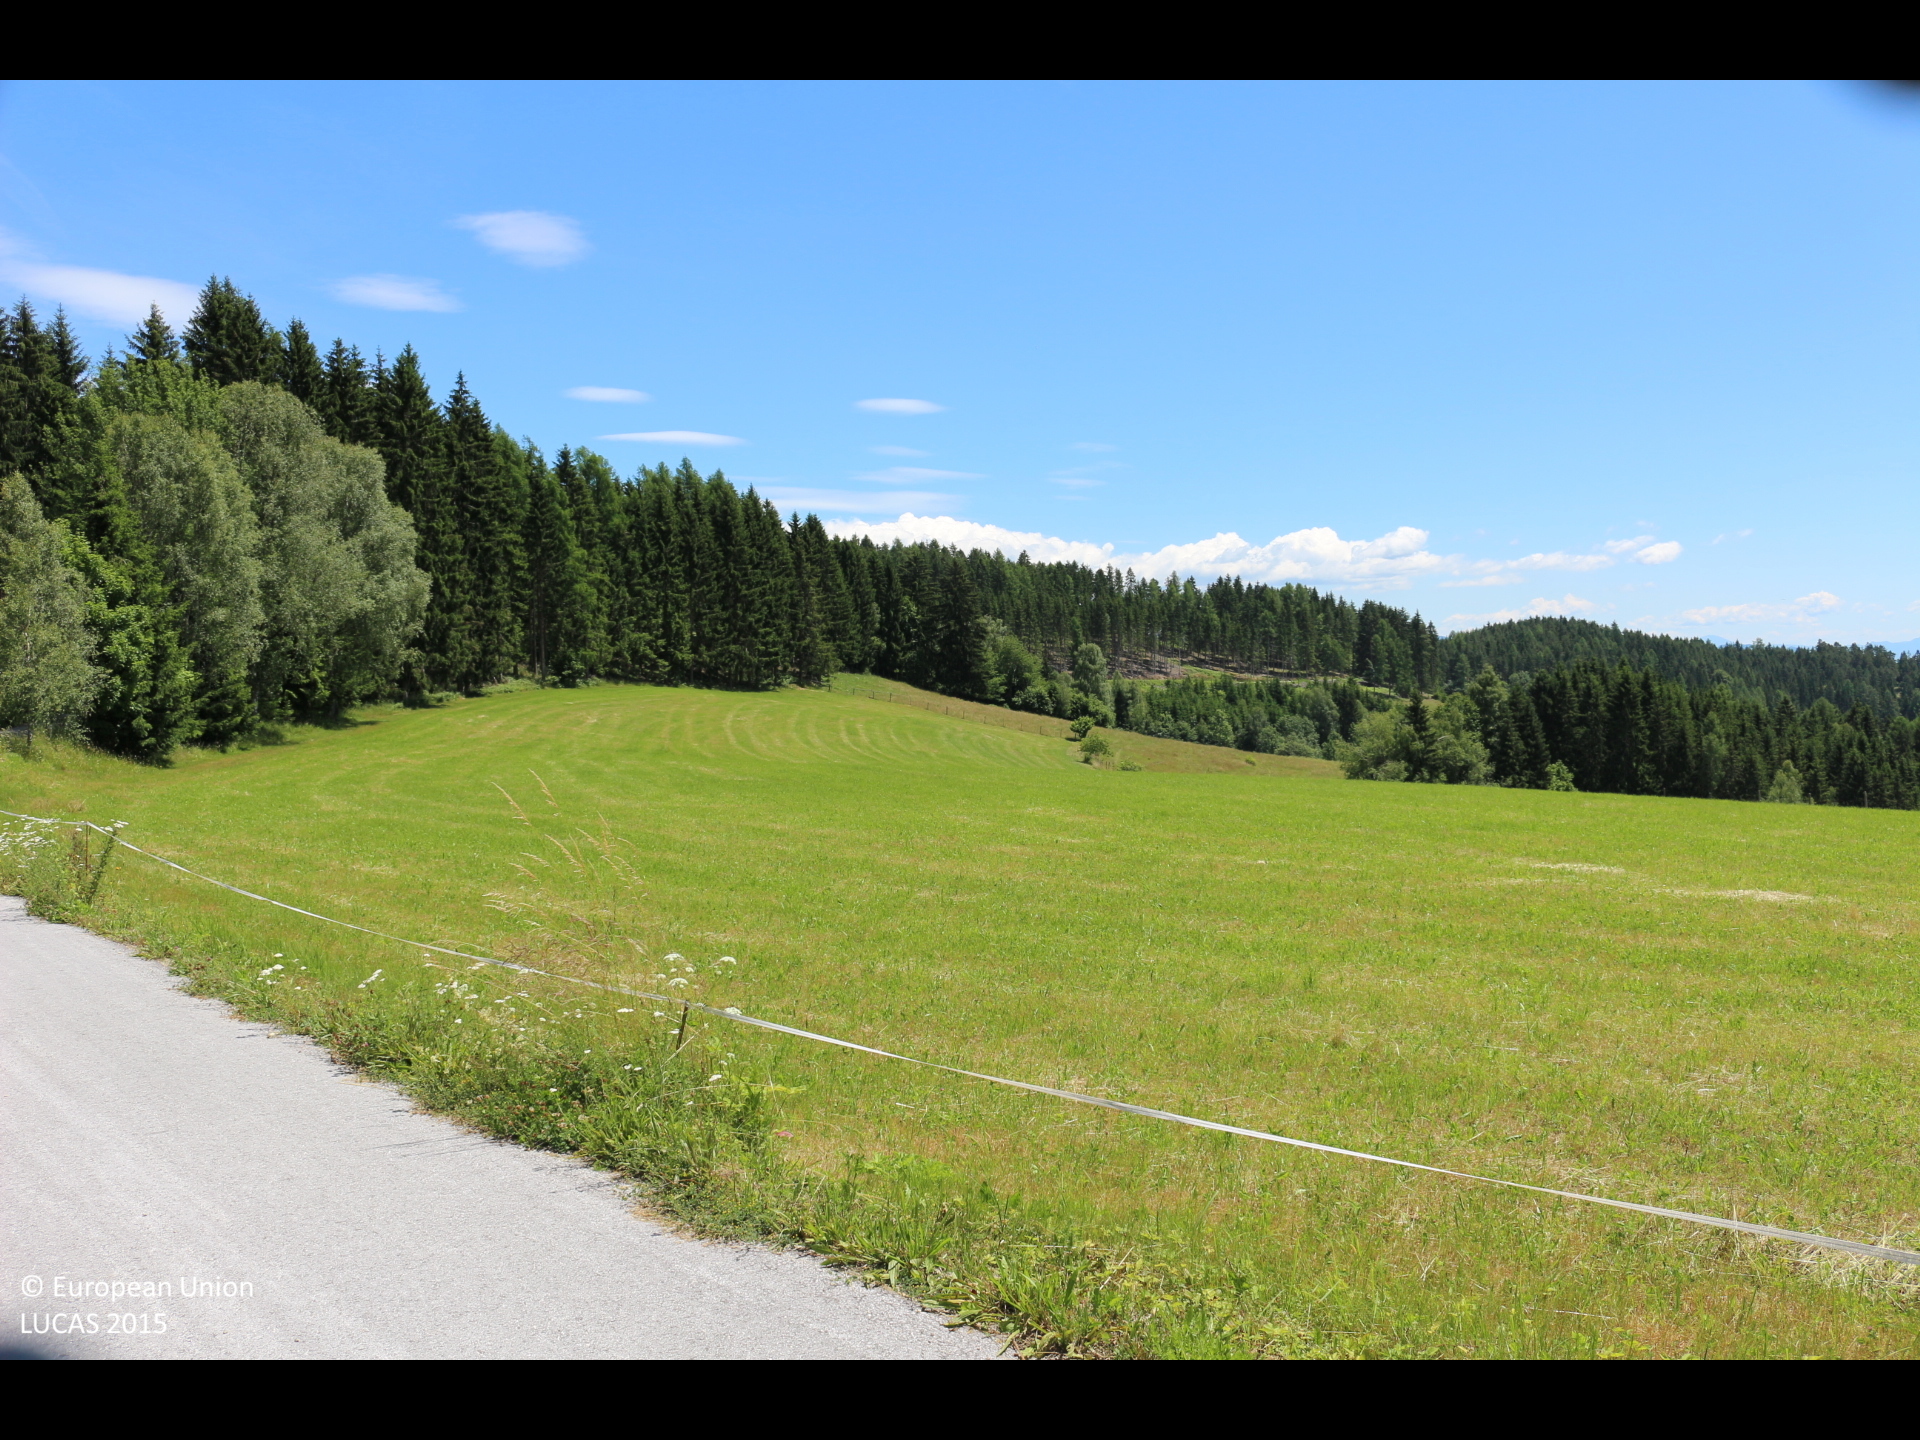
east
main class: Grassland
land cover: Grassland without tree/shrub cover
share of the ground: > 75 %
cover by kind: herbaceous plants 100 %
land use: Agriculture (excluding fallow land and kitchen gardens)
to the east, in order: Grassland without tree/shrub cover; Fences; Tracks; Fences; Grassland without tree/shrub cover; Spruce dominated coniferous woodland; Tracks; Spruce dominated coniferous woodland
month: June
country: AT
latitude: 46.8763
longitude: 14.3410
